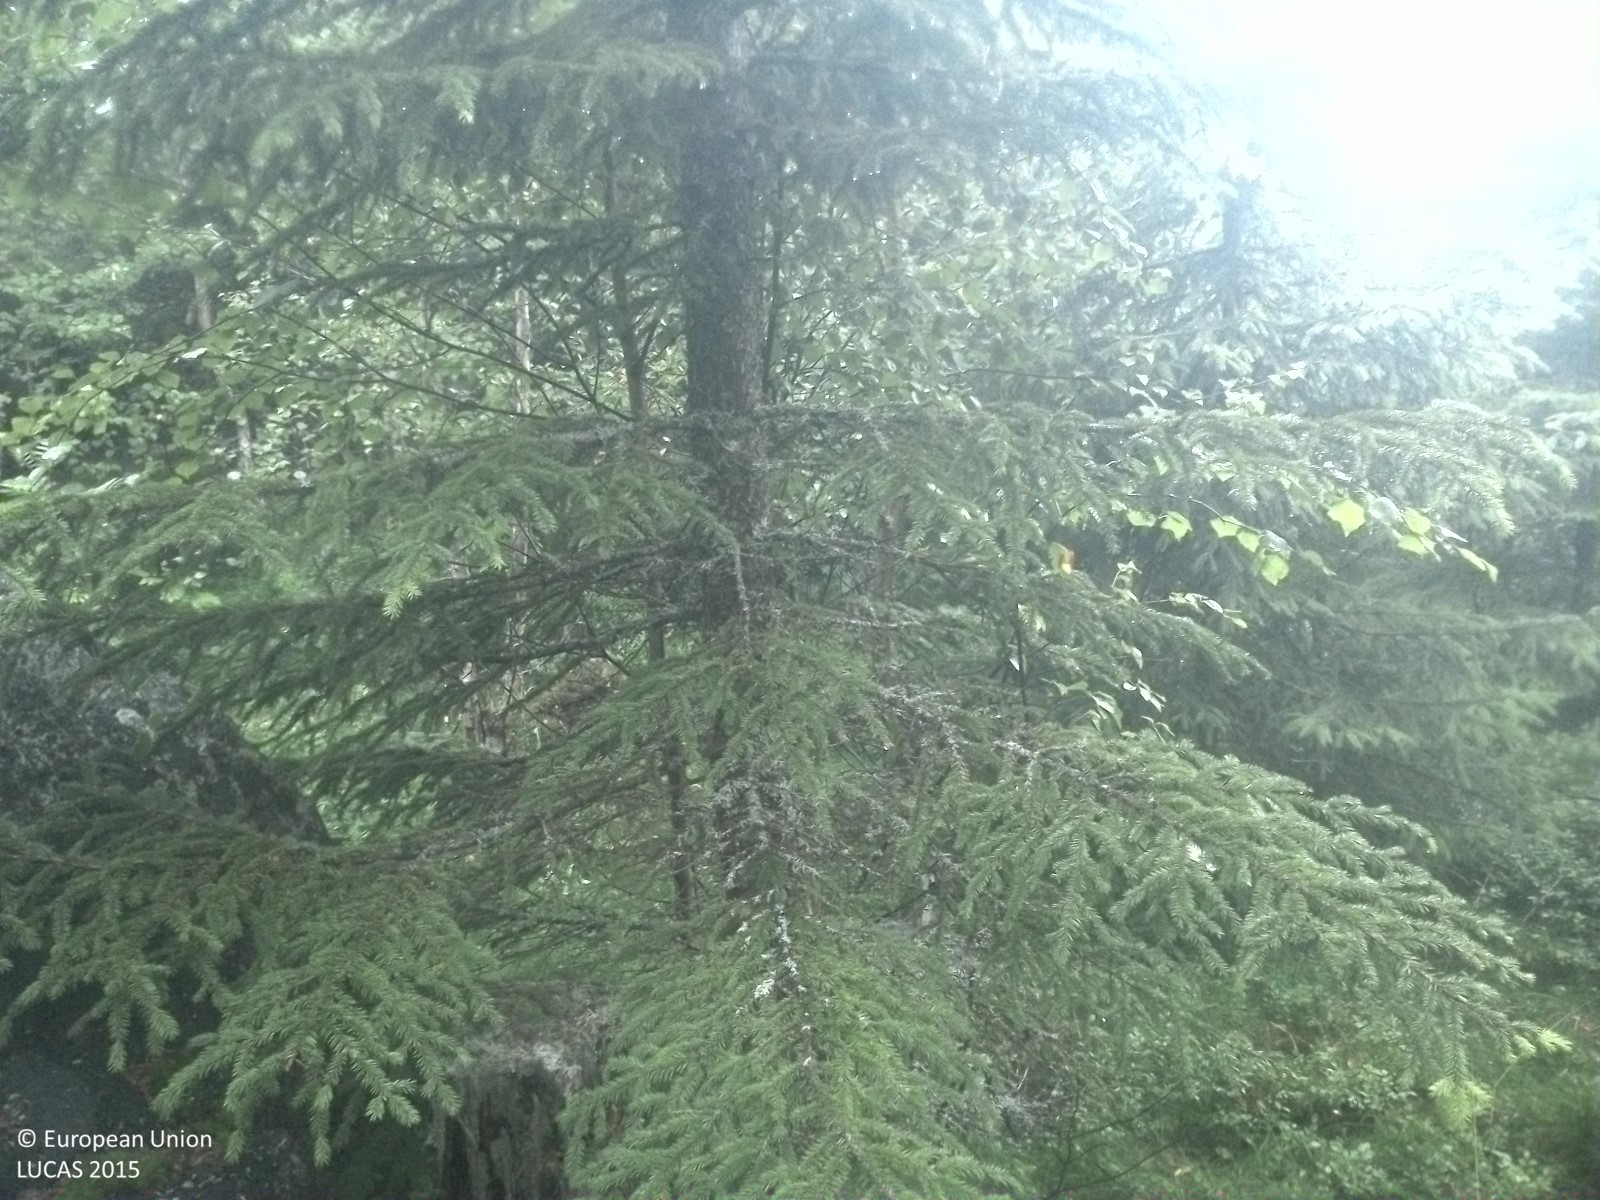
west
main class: Woodland
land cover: Spruce dominated mixed woodland
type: boreal forest
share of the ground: > 75 %
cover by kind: coniferous forest trees 45 %, broadleaved forest trees 30 %, herbaceous plants 25 %
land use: Forestry
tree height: > 5 m
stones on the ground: < 10 %
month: August
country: SE
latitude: 62.6173
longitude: 16.8973
